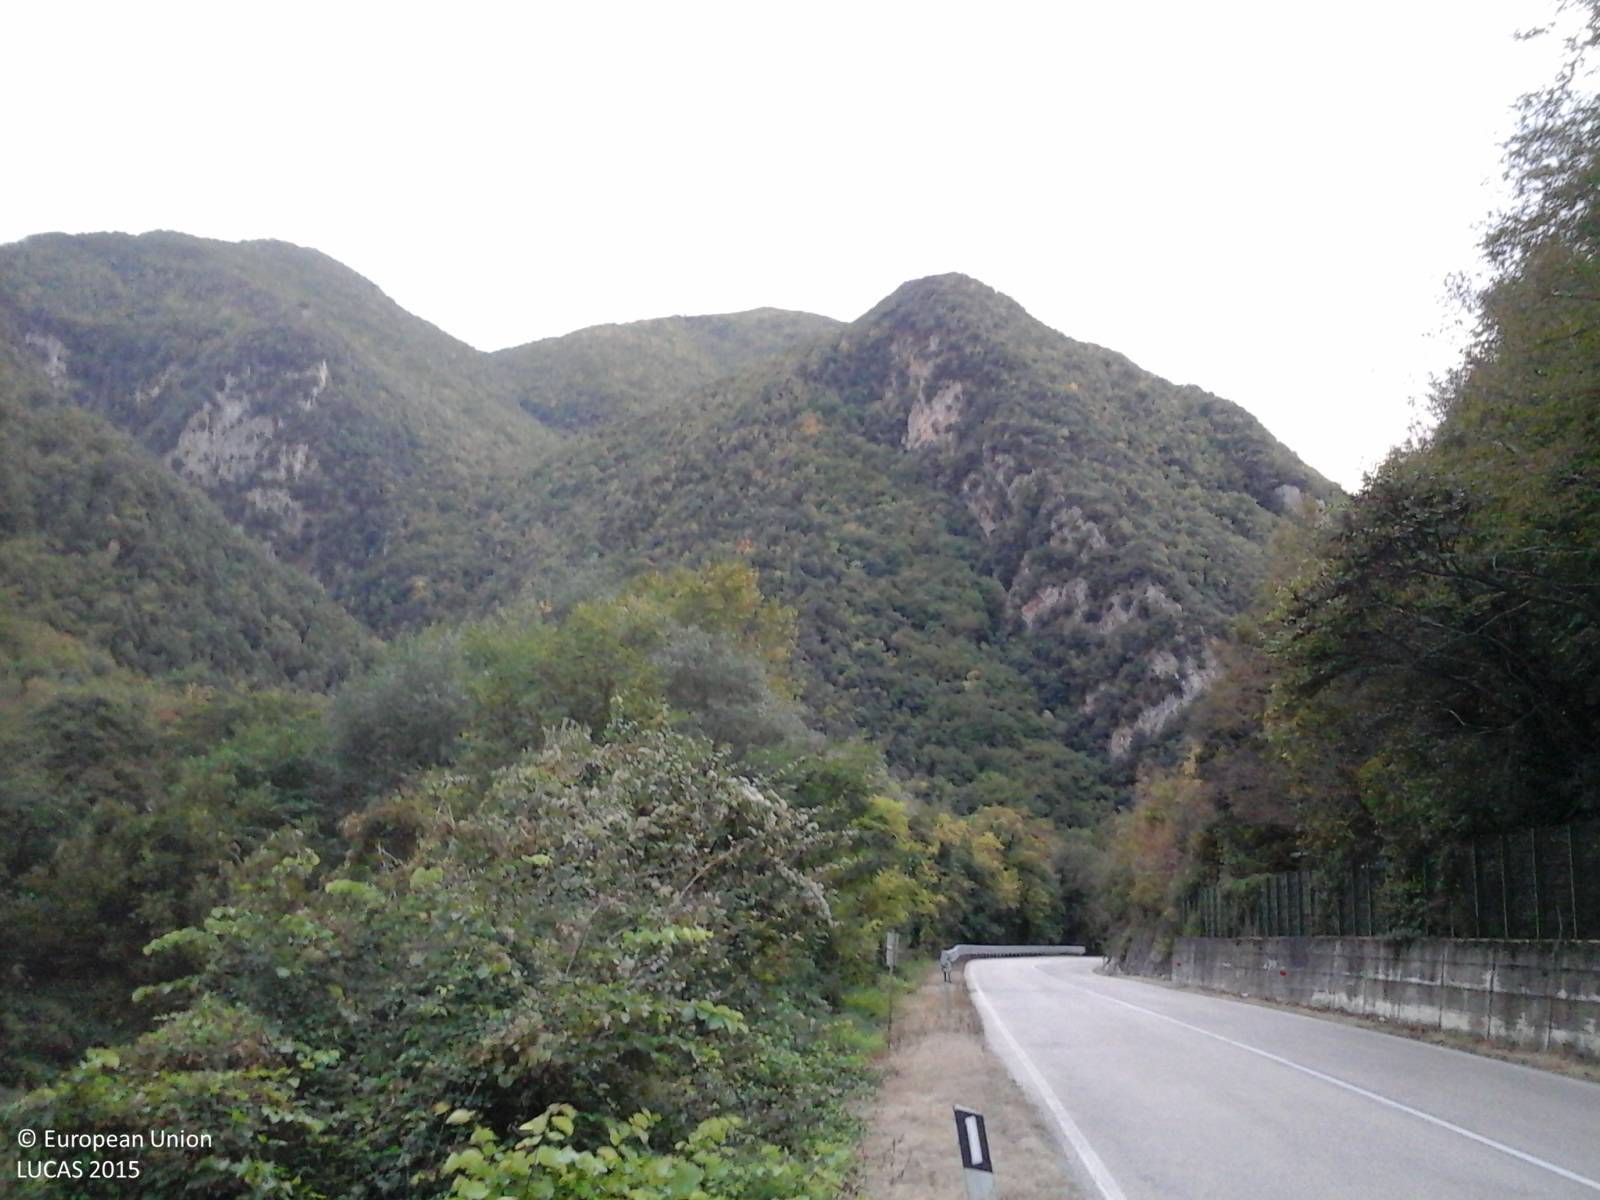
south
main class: Woodland
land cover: Broadleaved woodland
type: thermophilous deciduous forest
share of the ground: > 75 %
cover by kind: broadleaved forest trees 90 %, shrubs 10 %
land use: Forestry
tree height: > 5 m
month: October
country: IT
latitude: 42.7935
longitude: 12.8888
